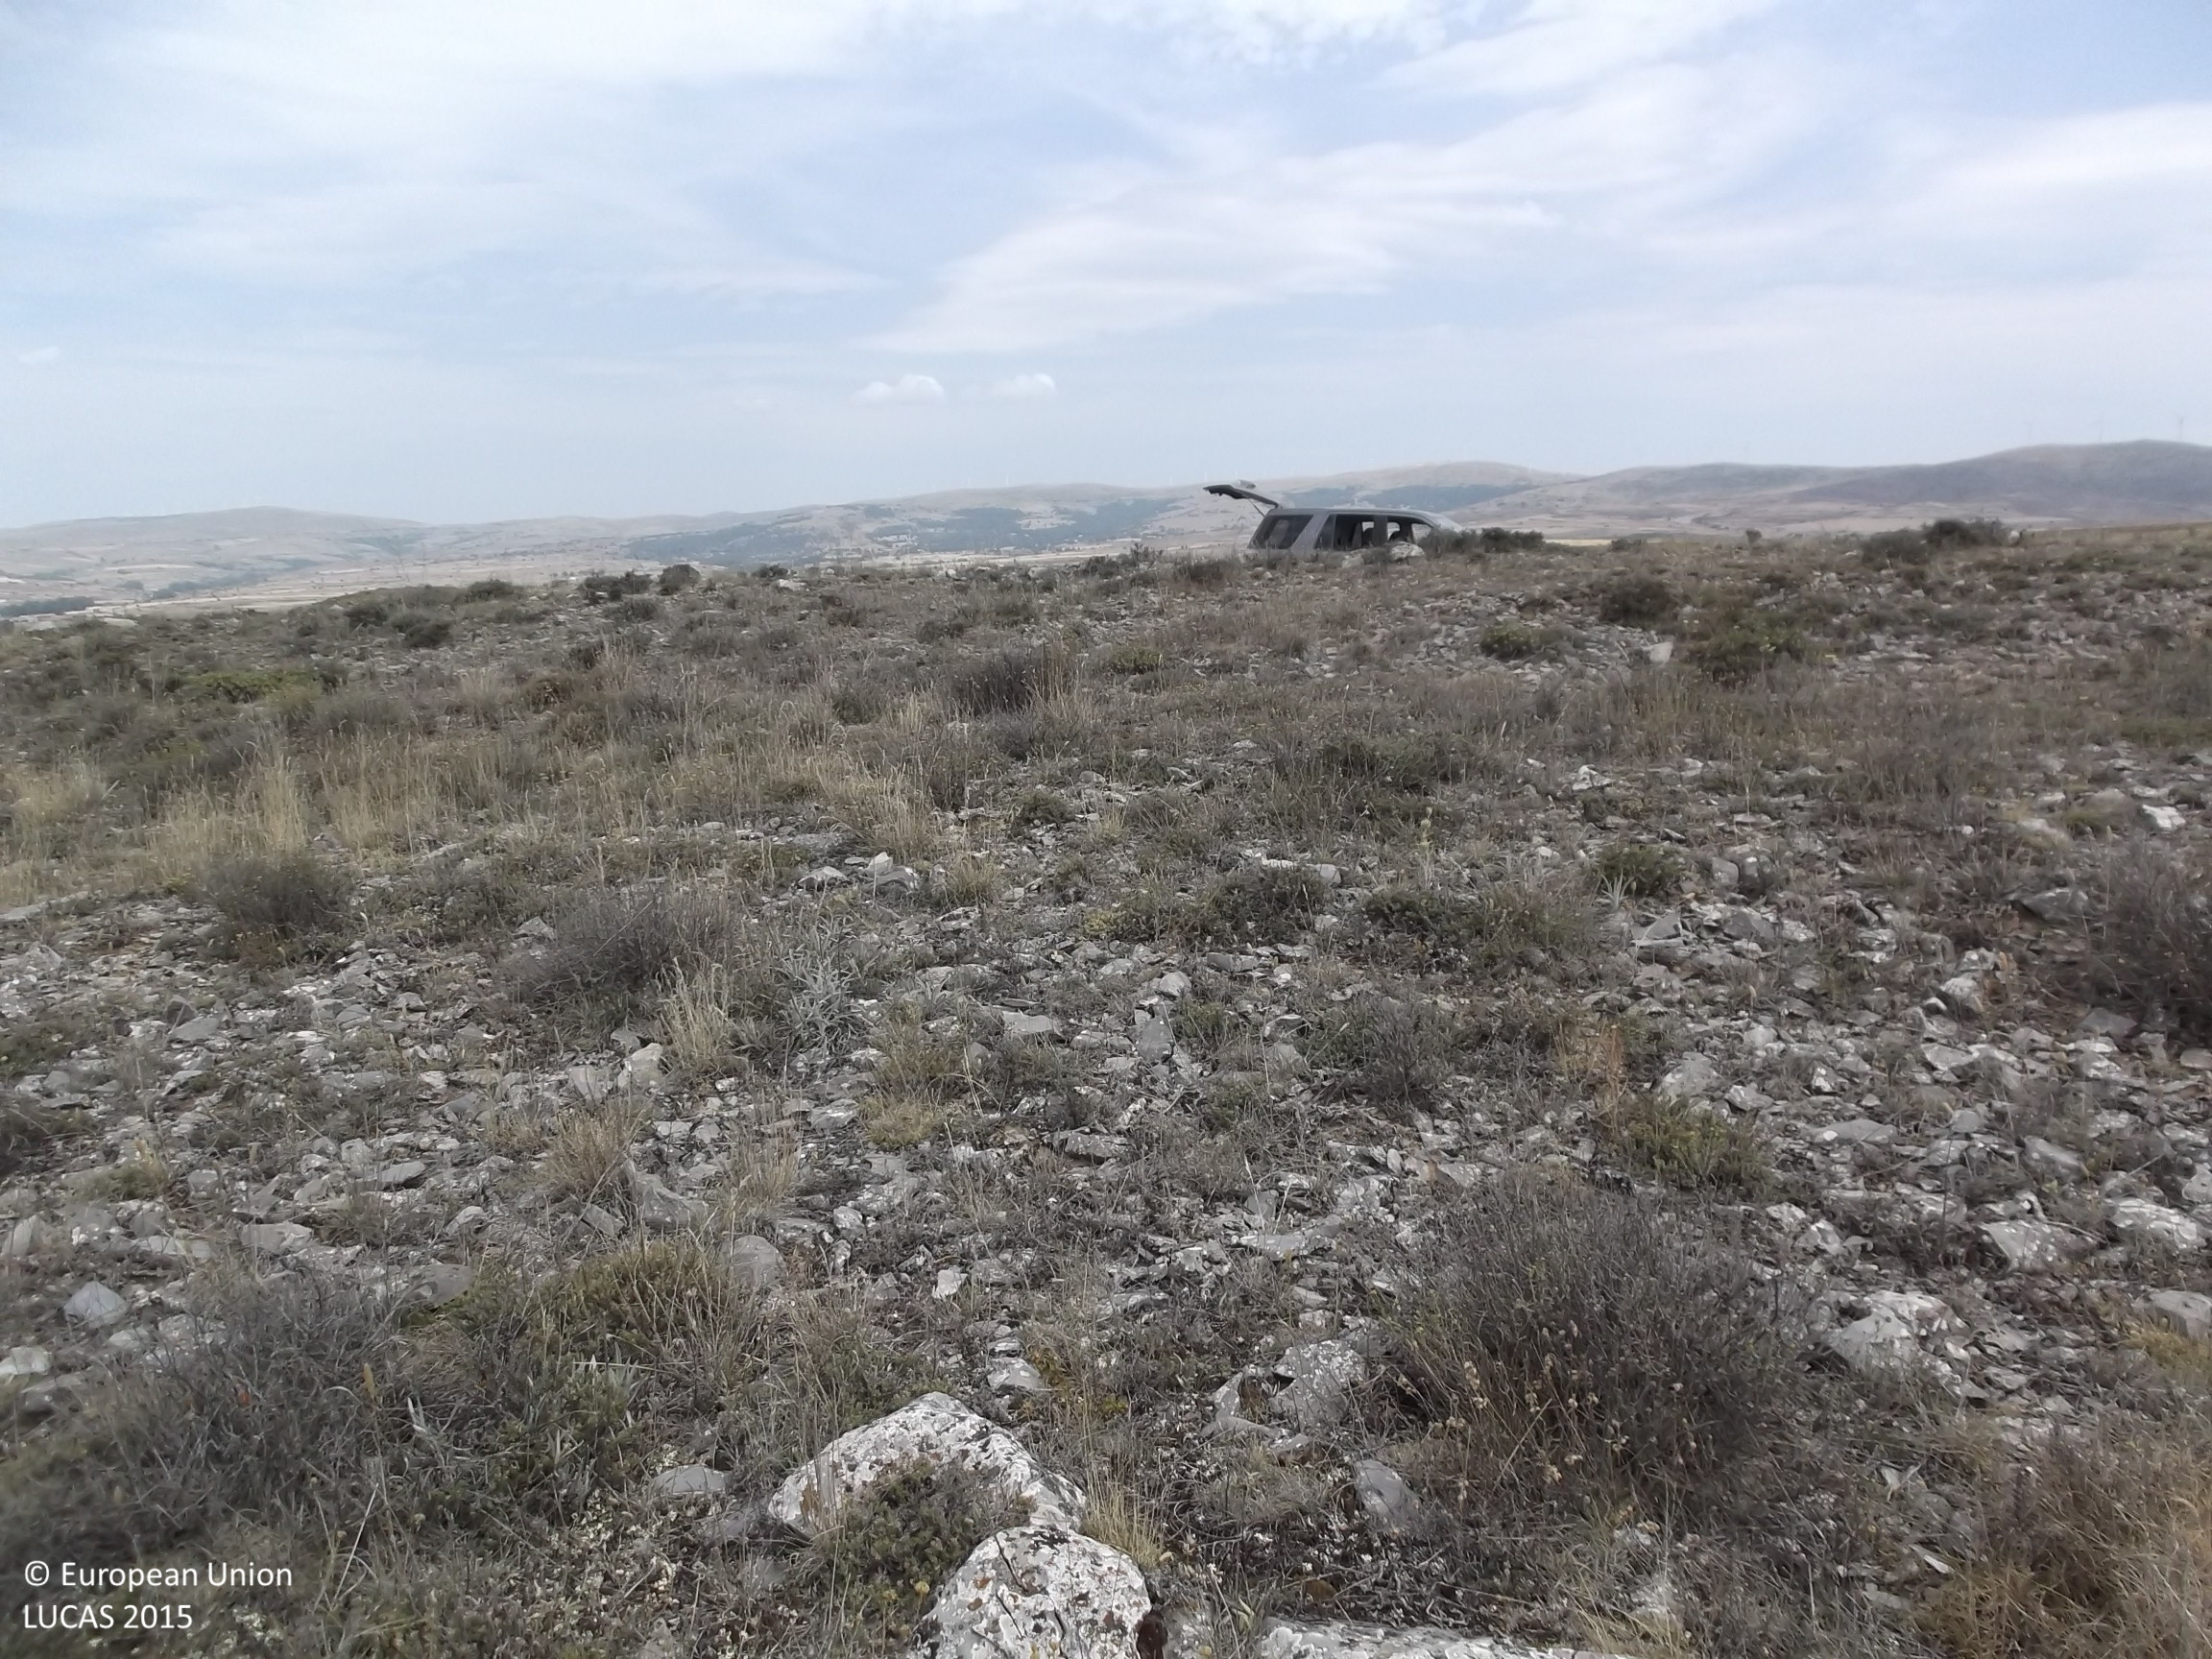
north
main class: Shrubland
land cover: Shrubland without tree cover
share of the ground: 50 - 75 %
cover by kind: shrubs 60 %, unconsolidated bare surface 30 %, herbaceous plants 10 %
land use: Semi-natural and natural areas not in use
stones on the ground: > 50 %
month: July
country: ES
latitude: 41.8839
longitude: -2.2930
